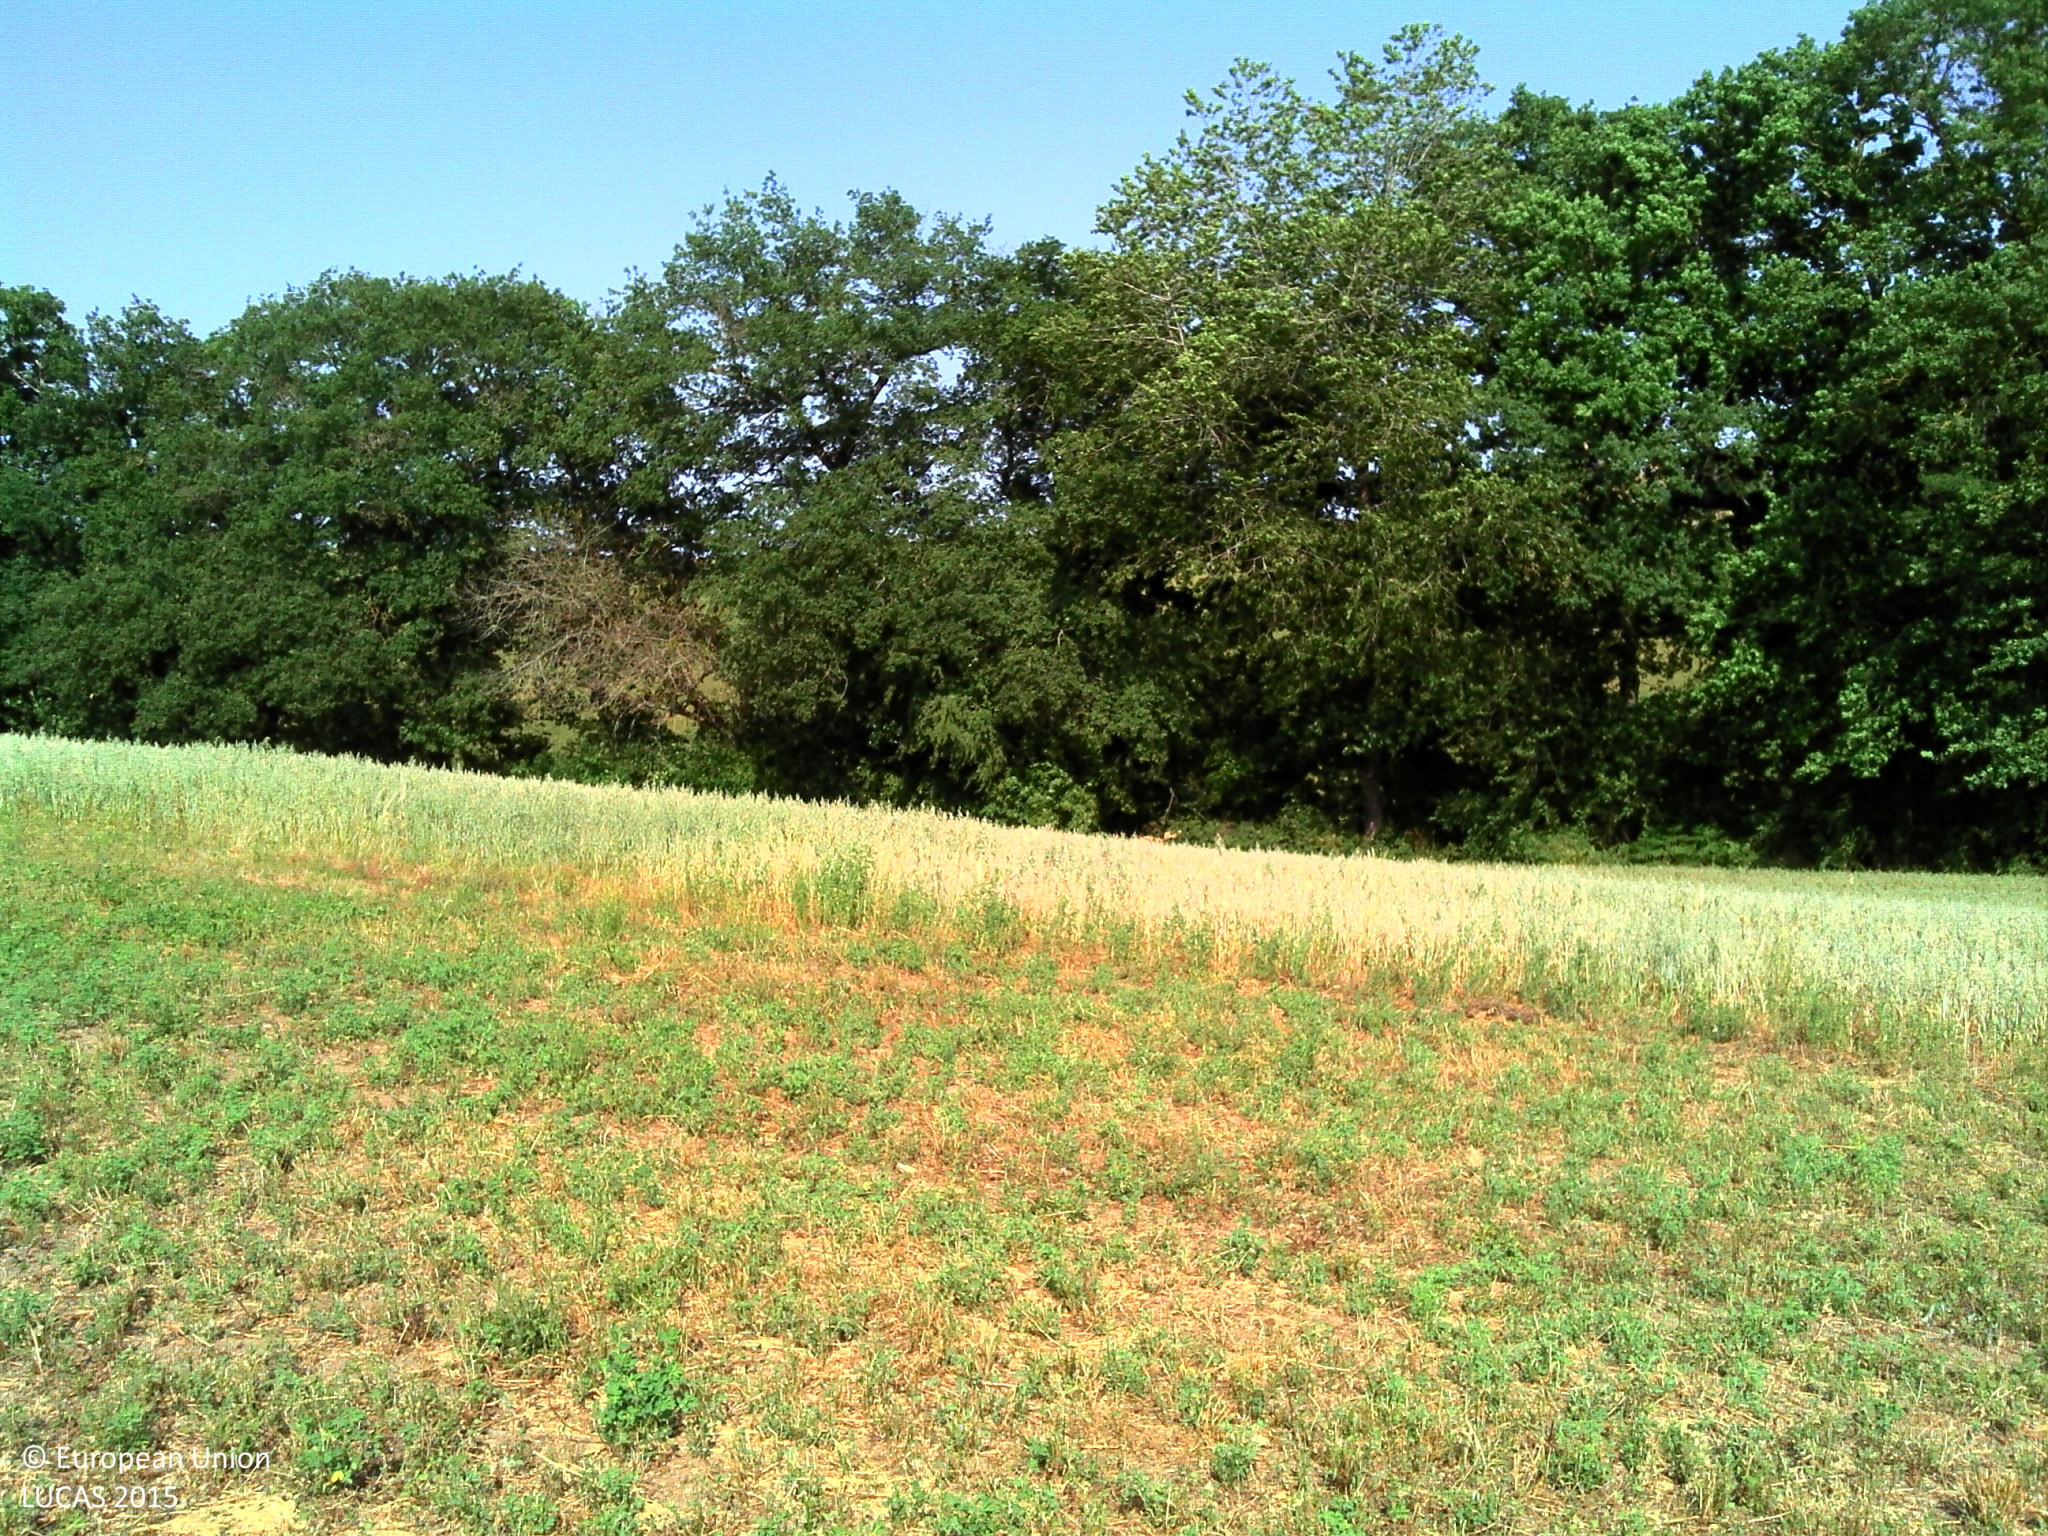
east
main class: Cropland
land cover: Lucerne
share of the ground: > 75 %
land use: Agriculture (excluding fallow land and kitchen gardens)
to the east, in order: Lucerne; Oats; Broadleaved woodland; Fences; Groves; Grassland without tree/shrub cover
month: July
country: FR
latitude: 44.1399
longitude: 2.5917
